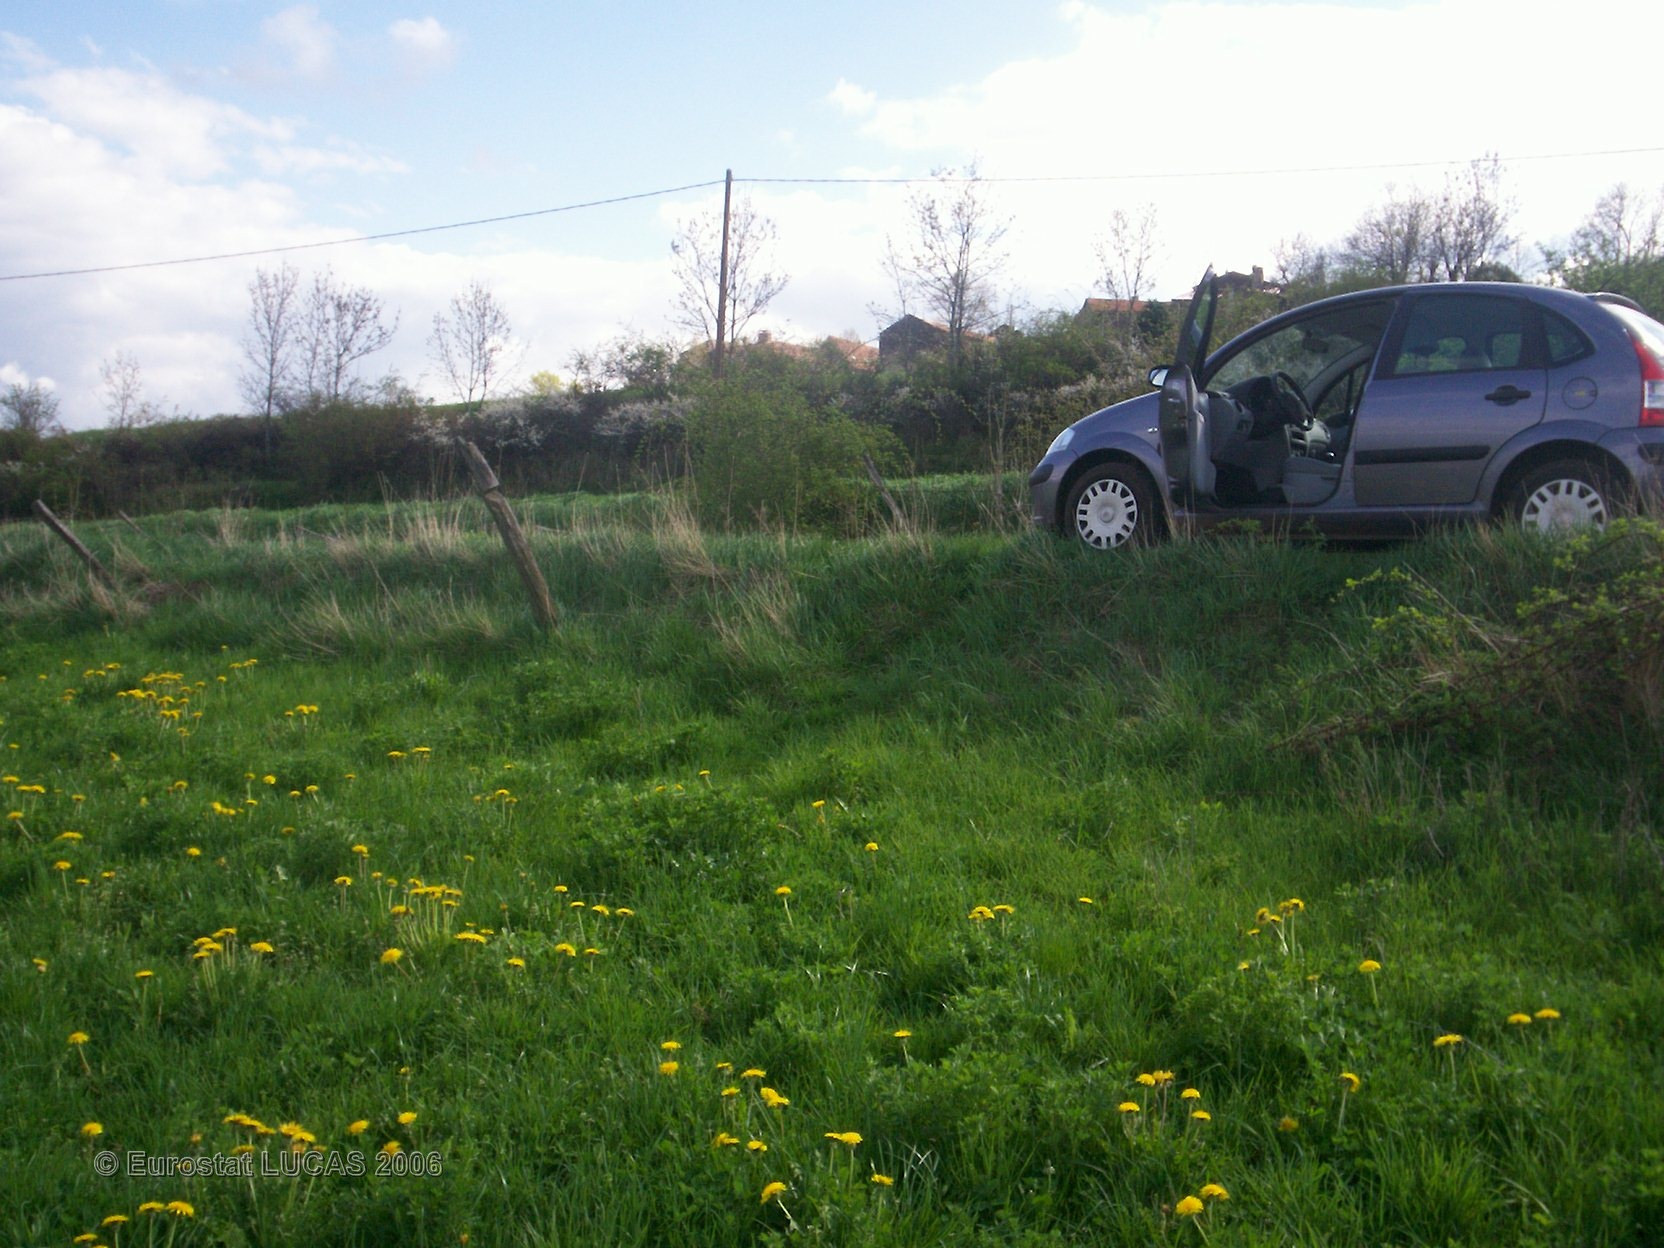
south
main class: Grassland
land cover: Grassland without tree/shrub cover
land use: Agriculture (excluding fallow land and kitchen gardens)
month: April
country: FR
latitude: 45.4257
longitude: 3.1377
